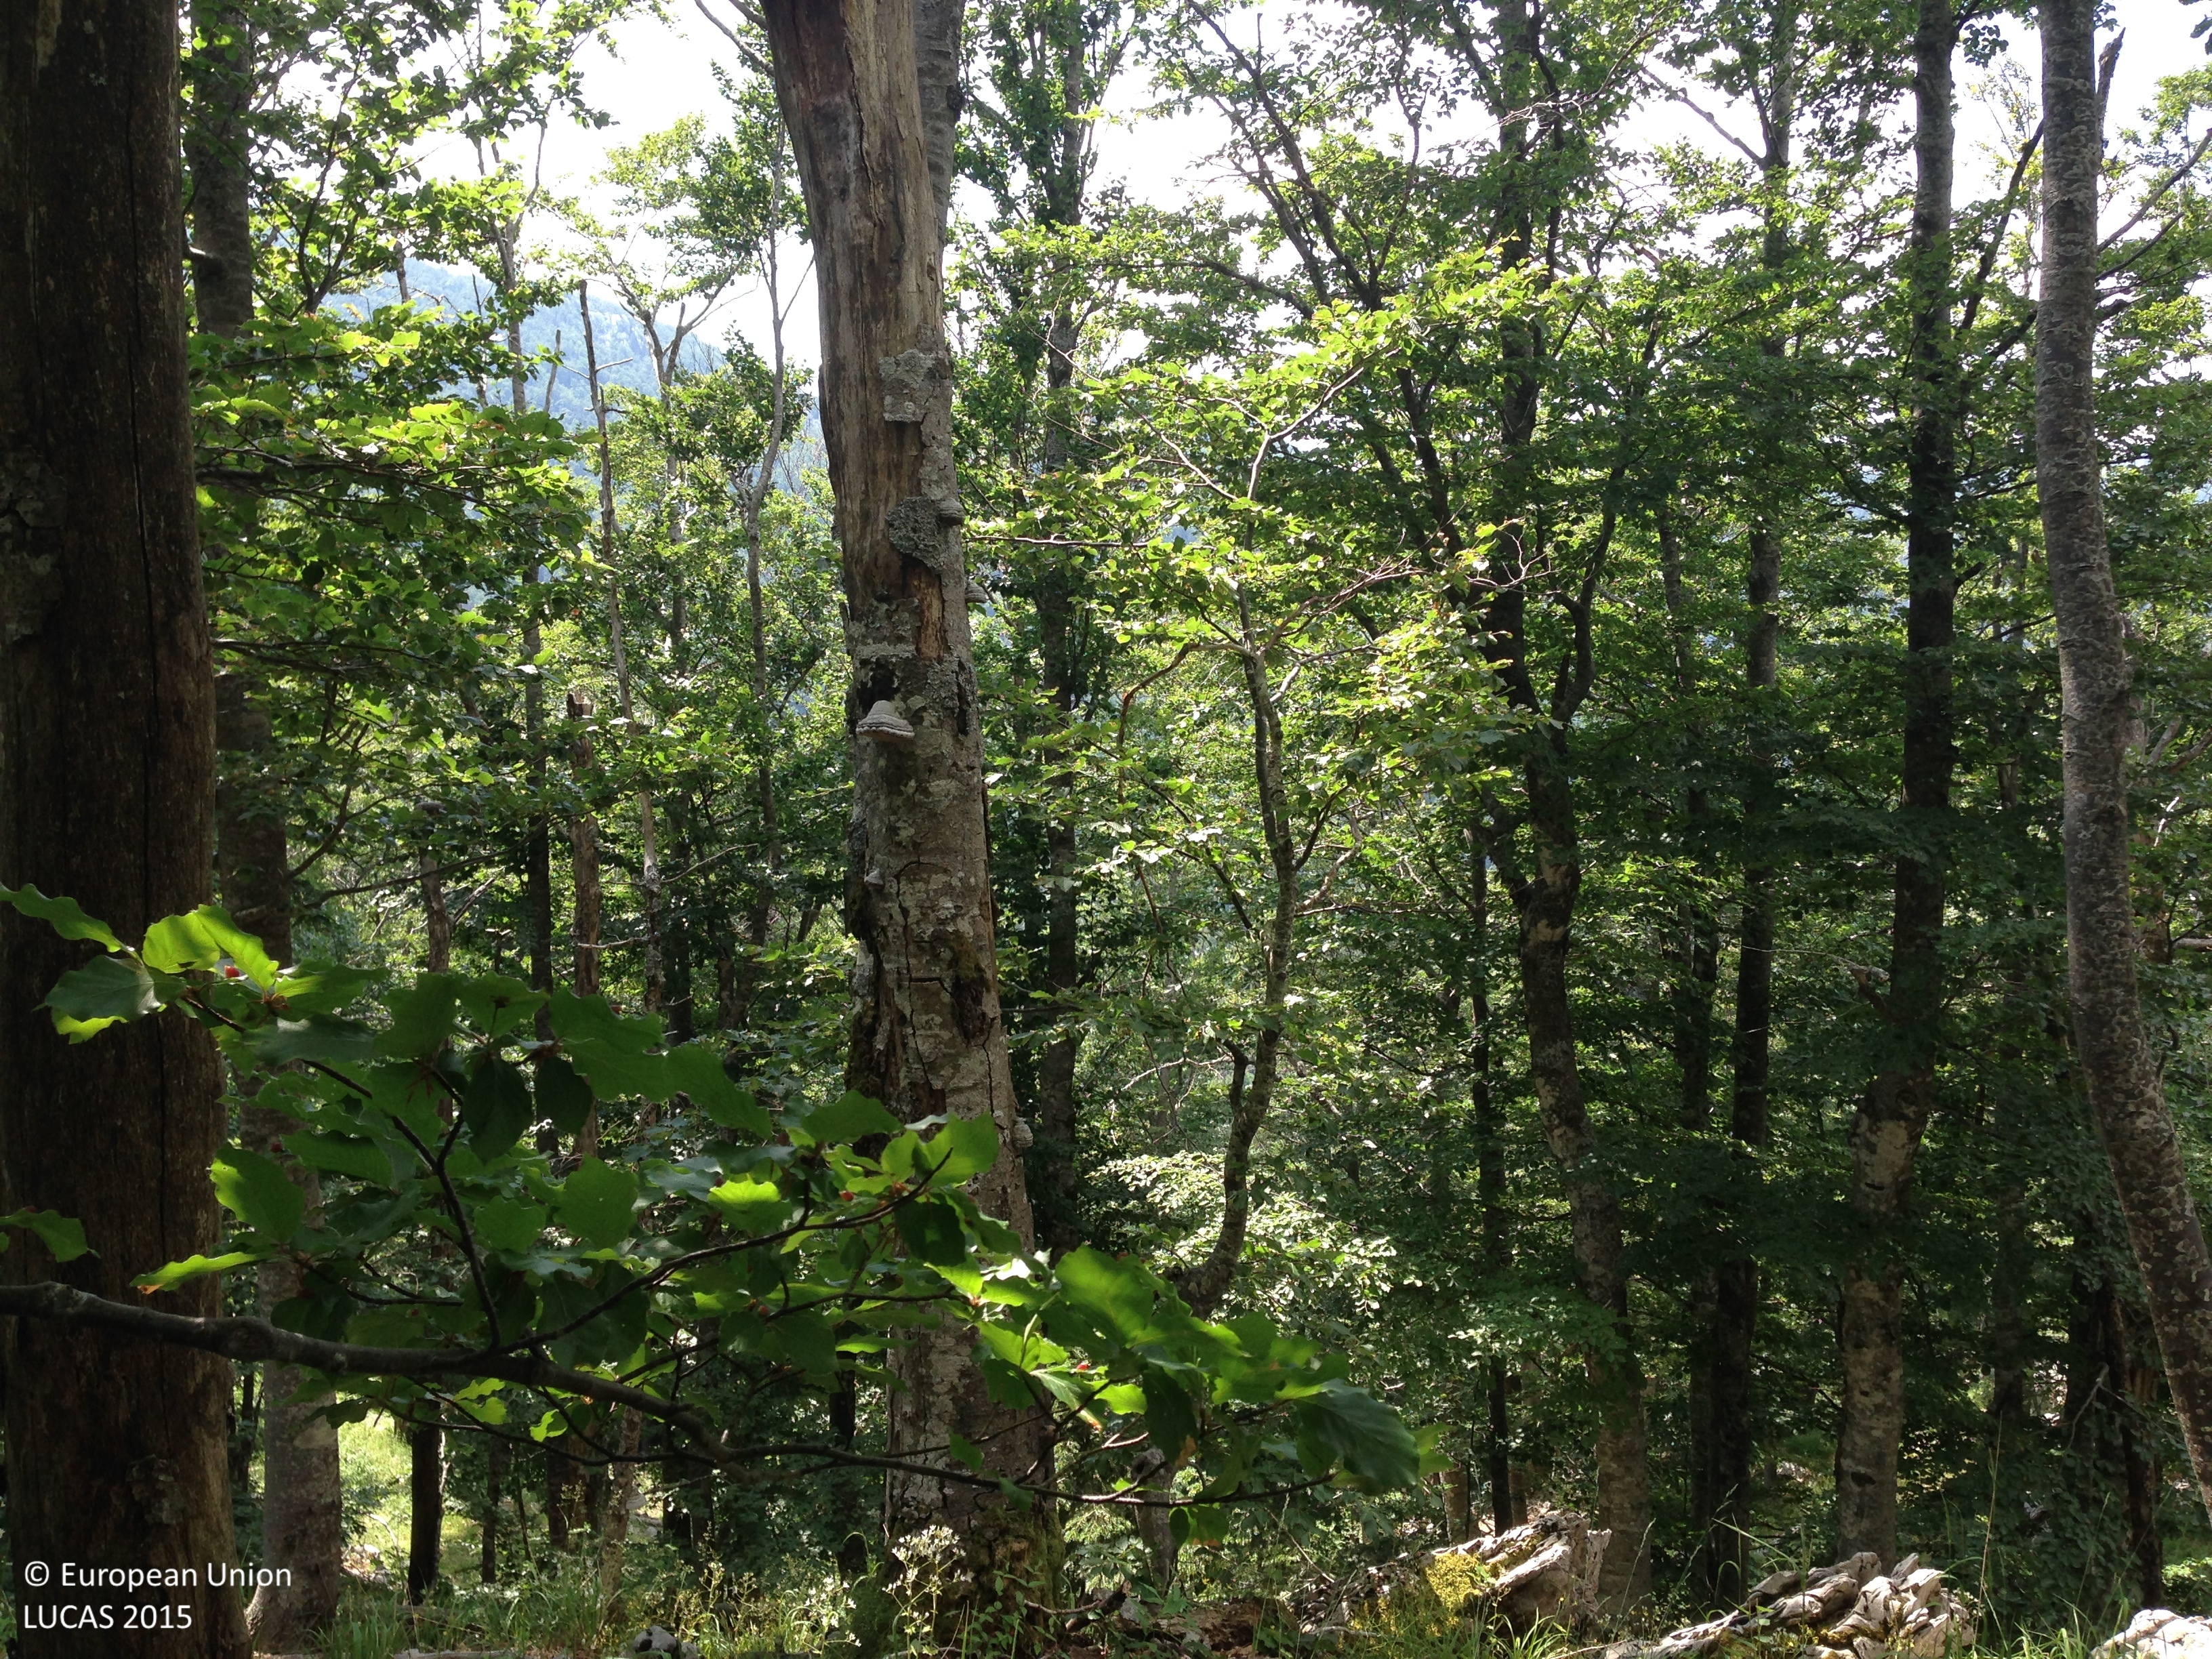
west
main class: Woodland
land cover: Other mixed woodland
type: thermophilous deciduous forest
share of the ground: > 75 %
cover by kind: broadleaved forest trees 40 %, coniferous forest trees 20 %, herbaceous plants 20 %, consolidated bare surface 10 %, shrubs 5 %, unconsolidated bare surface 5 %
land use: Forestry
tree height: > 5 m
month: July
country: HR
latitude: 44.6240
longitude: 15.0727
